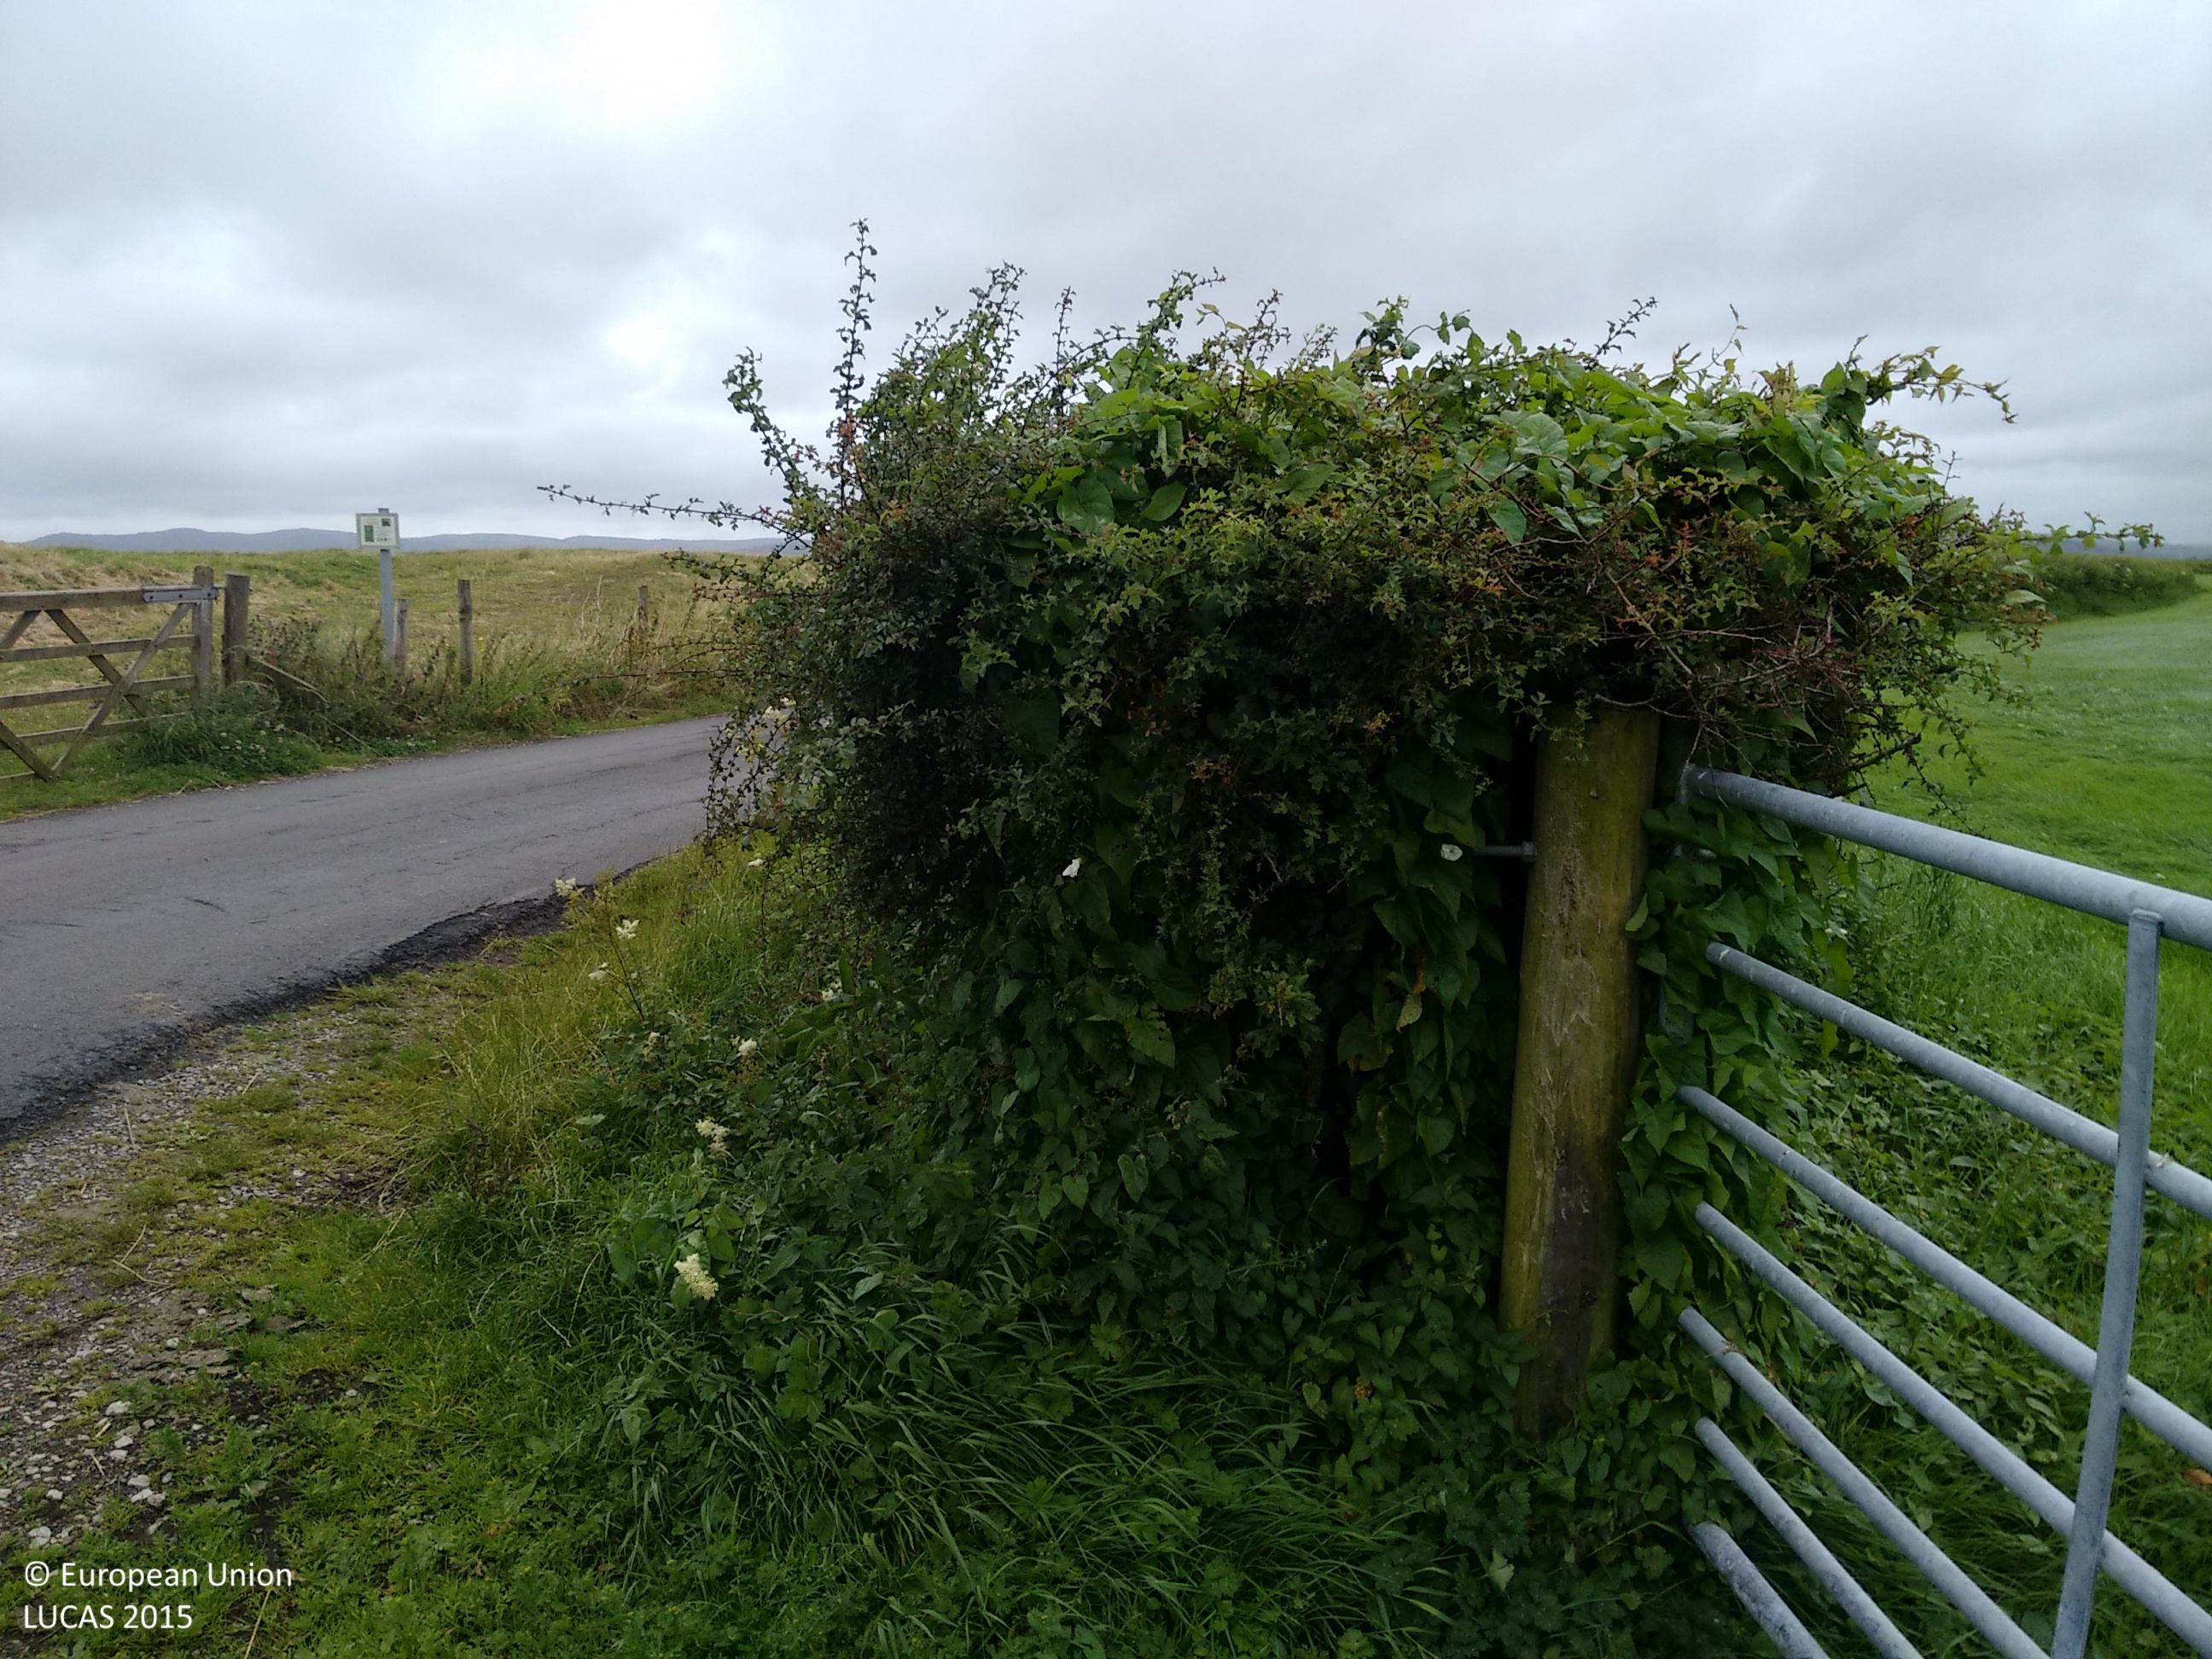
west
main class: Grassland
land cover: Grassland without tree/shrub cover
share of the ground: > 75 %
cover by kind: herbaceous plants 100 %
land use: Agriculture (excluding fallow land and kitchen gardens)
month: August
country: GB
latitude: 54.2325
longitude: -2.7872
